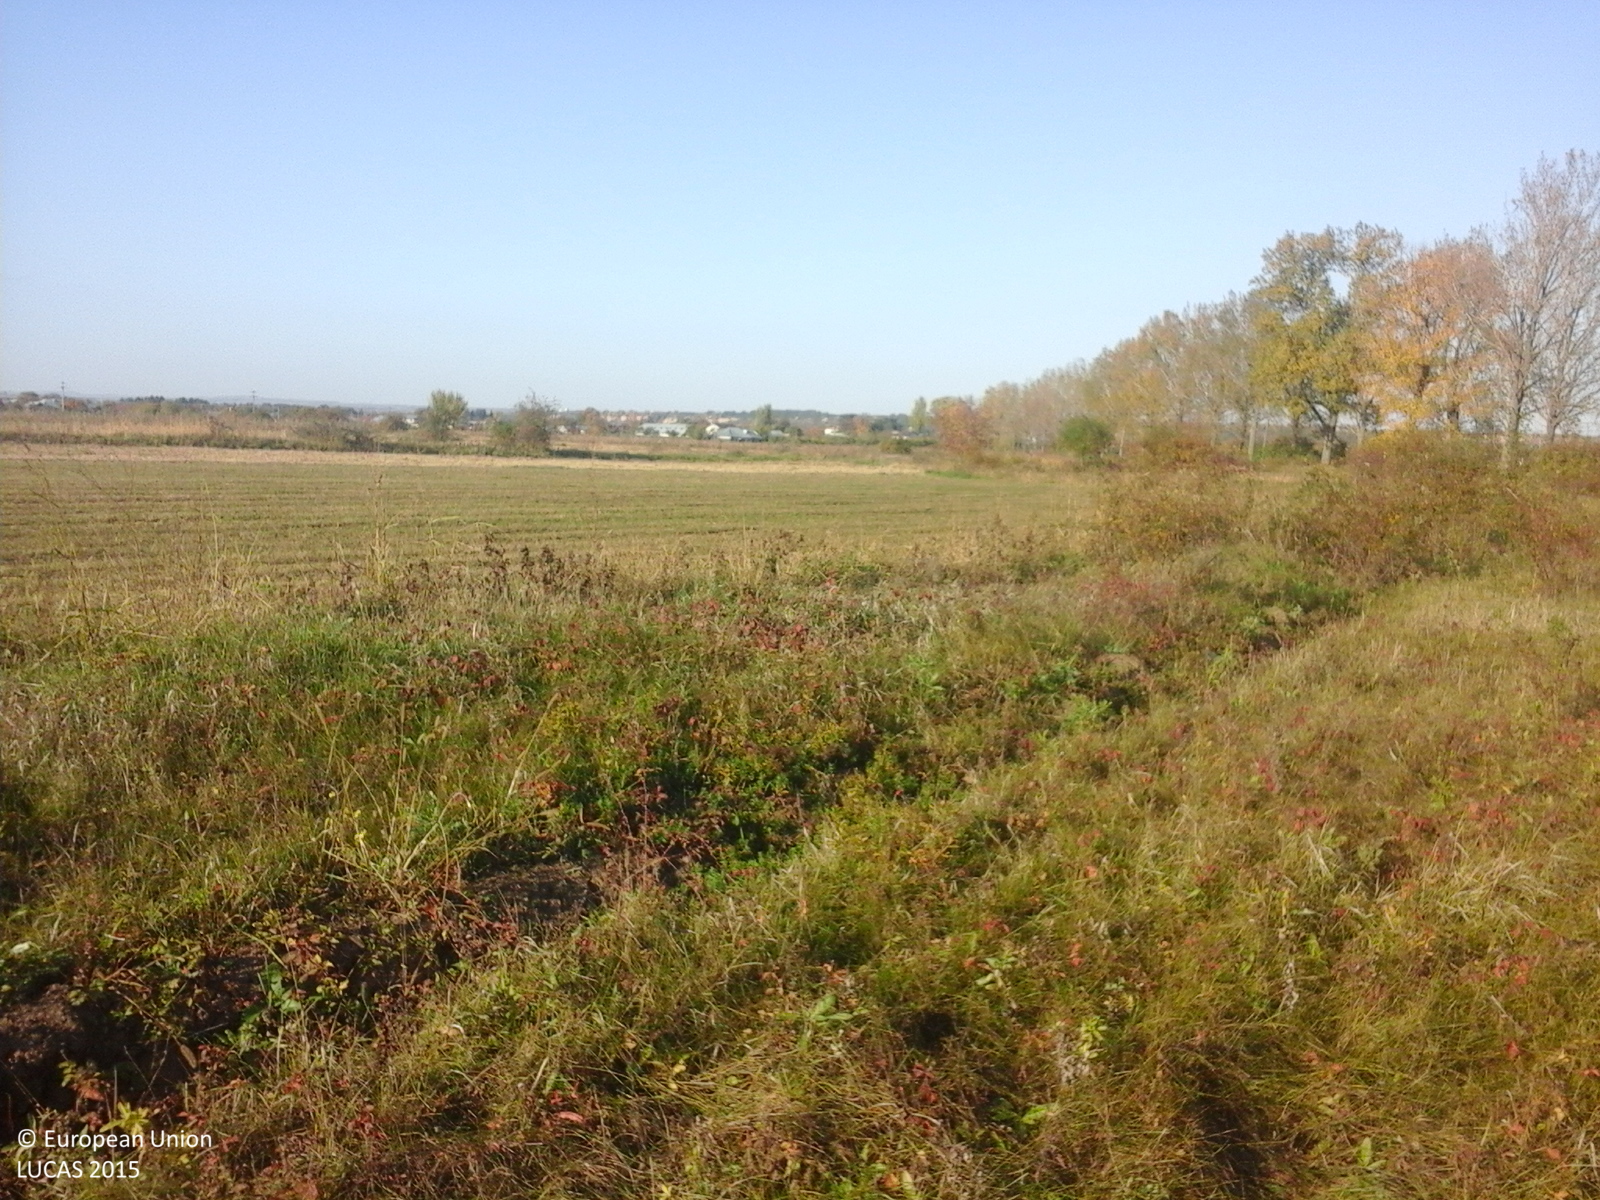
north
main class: Grassland
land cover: Spontaneously vegetated surfaces
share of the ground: > 75 %
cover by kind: herbaceous plants 100 %
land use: Fallow land
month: October
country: RO
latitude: 45.8301
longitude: 27.0723
